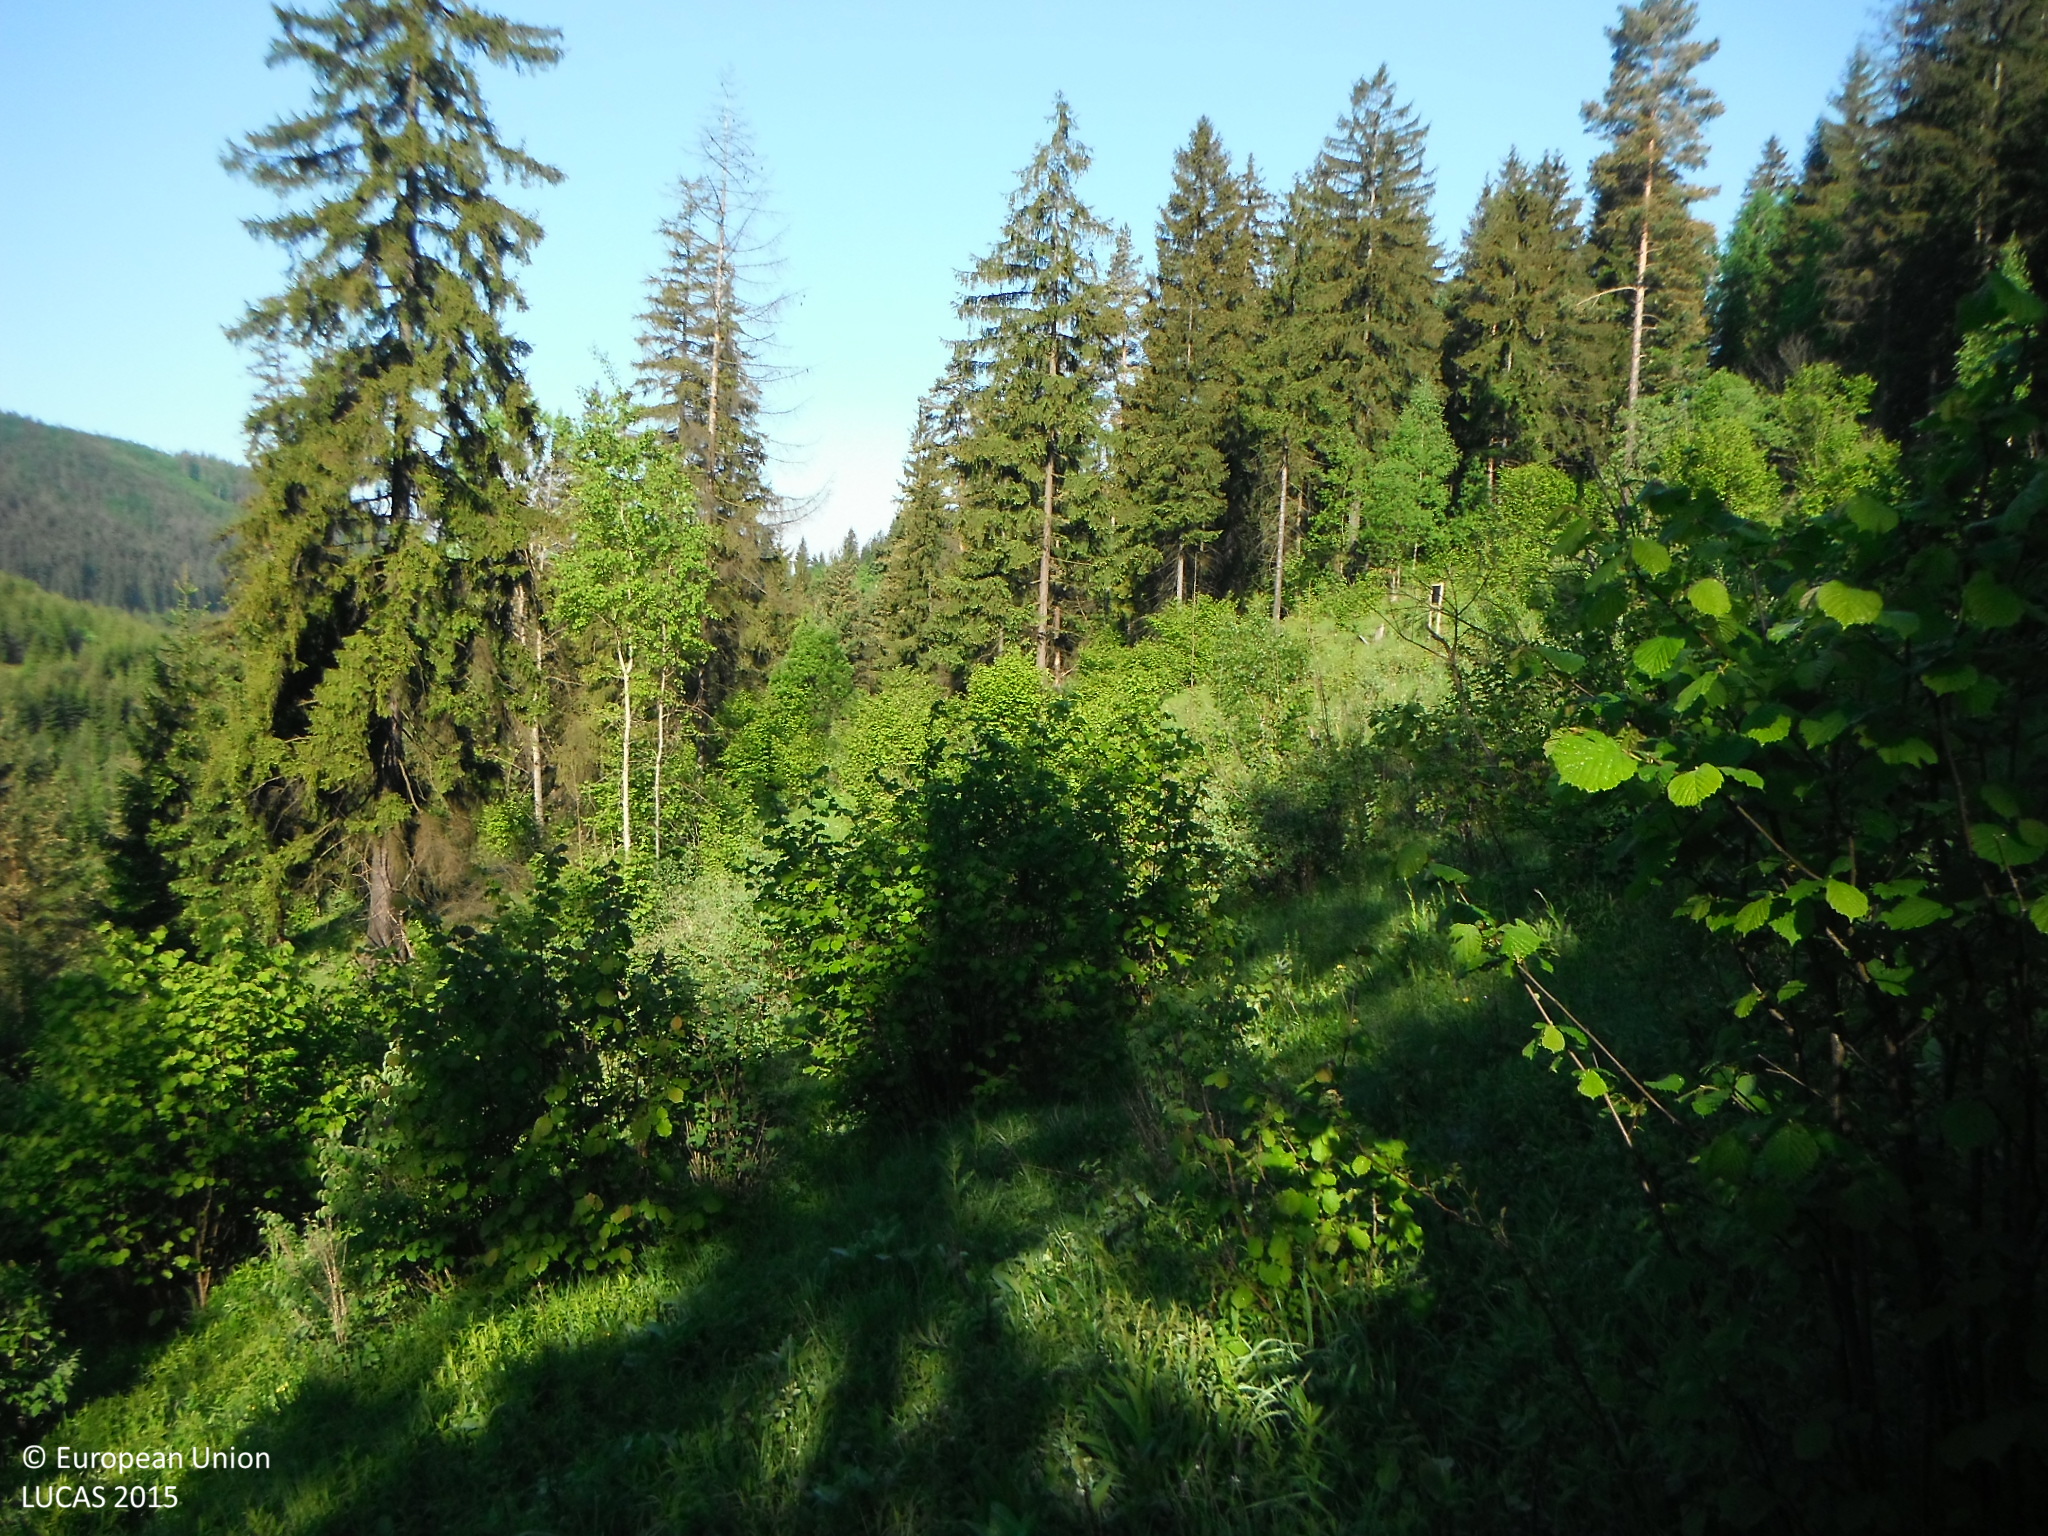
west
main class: Shrubland
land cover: Shrubland with sparse tree cover
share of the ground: > 75 %
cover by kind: shrubs 60 %, herbaceous plants 35 %, coniferous forest trees 5 %
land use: Forestry
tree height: > 5 m
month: June
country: SK
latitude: 49.0591
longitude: 19.9520
